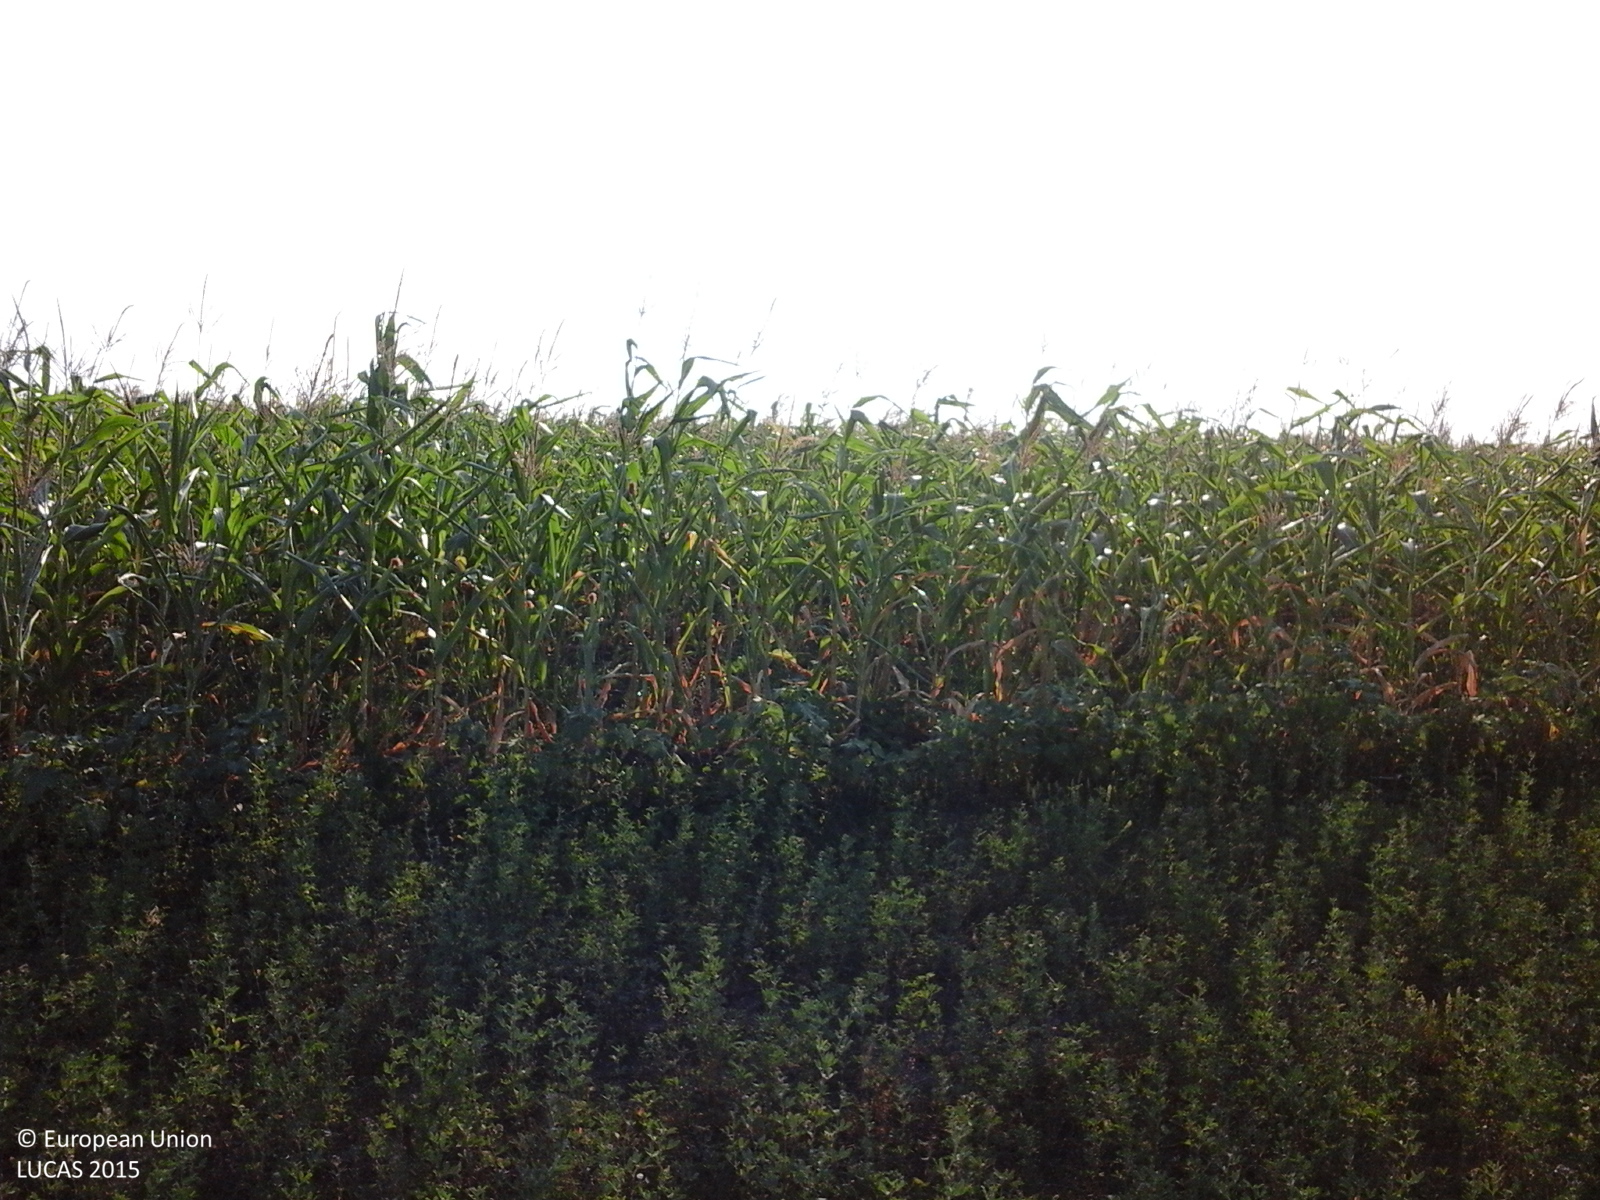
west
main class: Cropland
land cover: Lucerne
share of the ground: > 75 %
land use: Agriculture (excluding fallow land and kitchen gardens)
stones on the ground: < 10 %
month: July
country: RO
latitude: 46.3086
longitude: 27.6296
